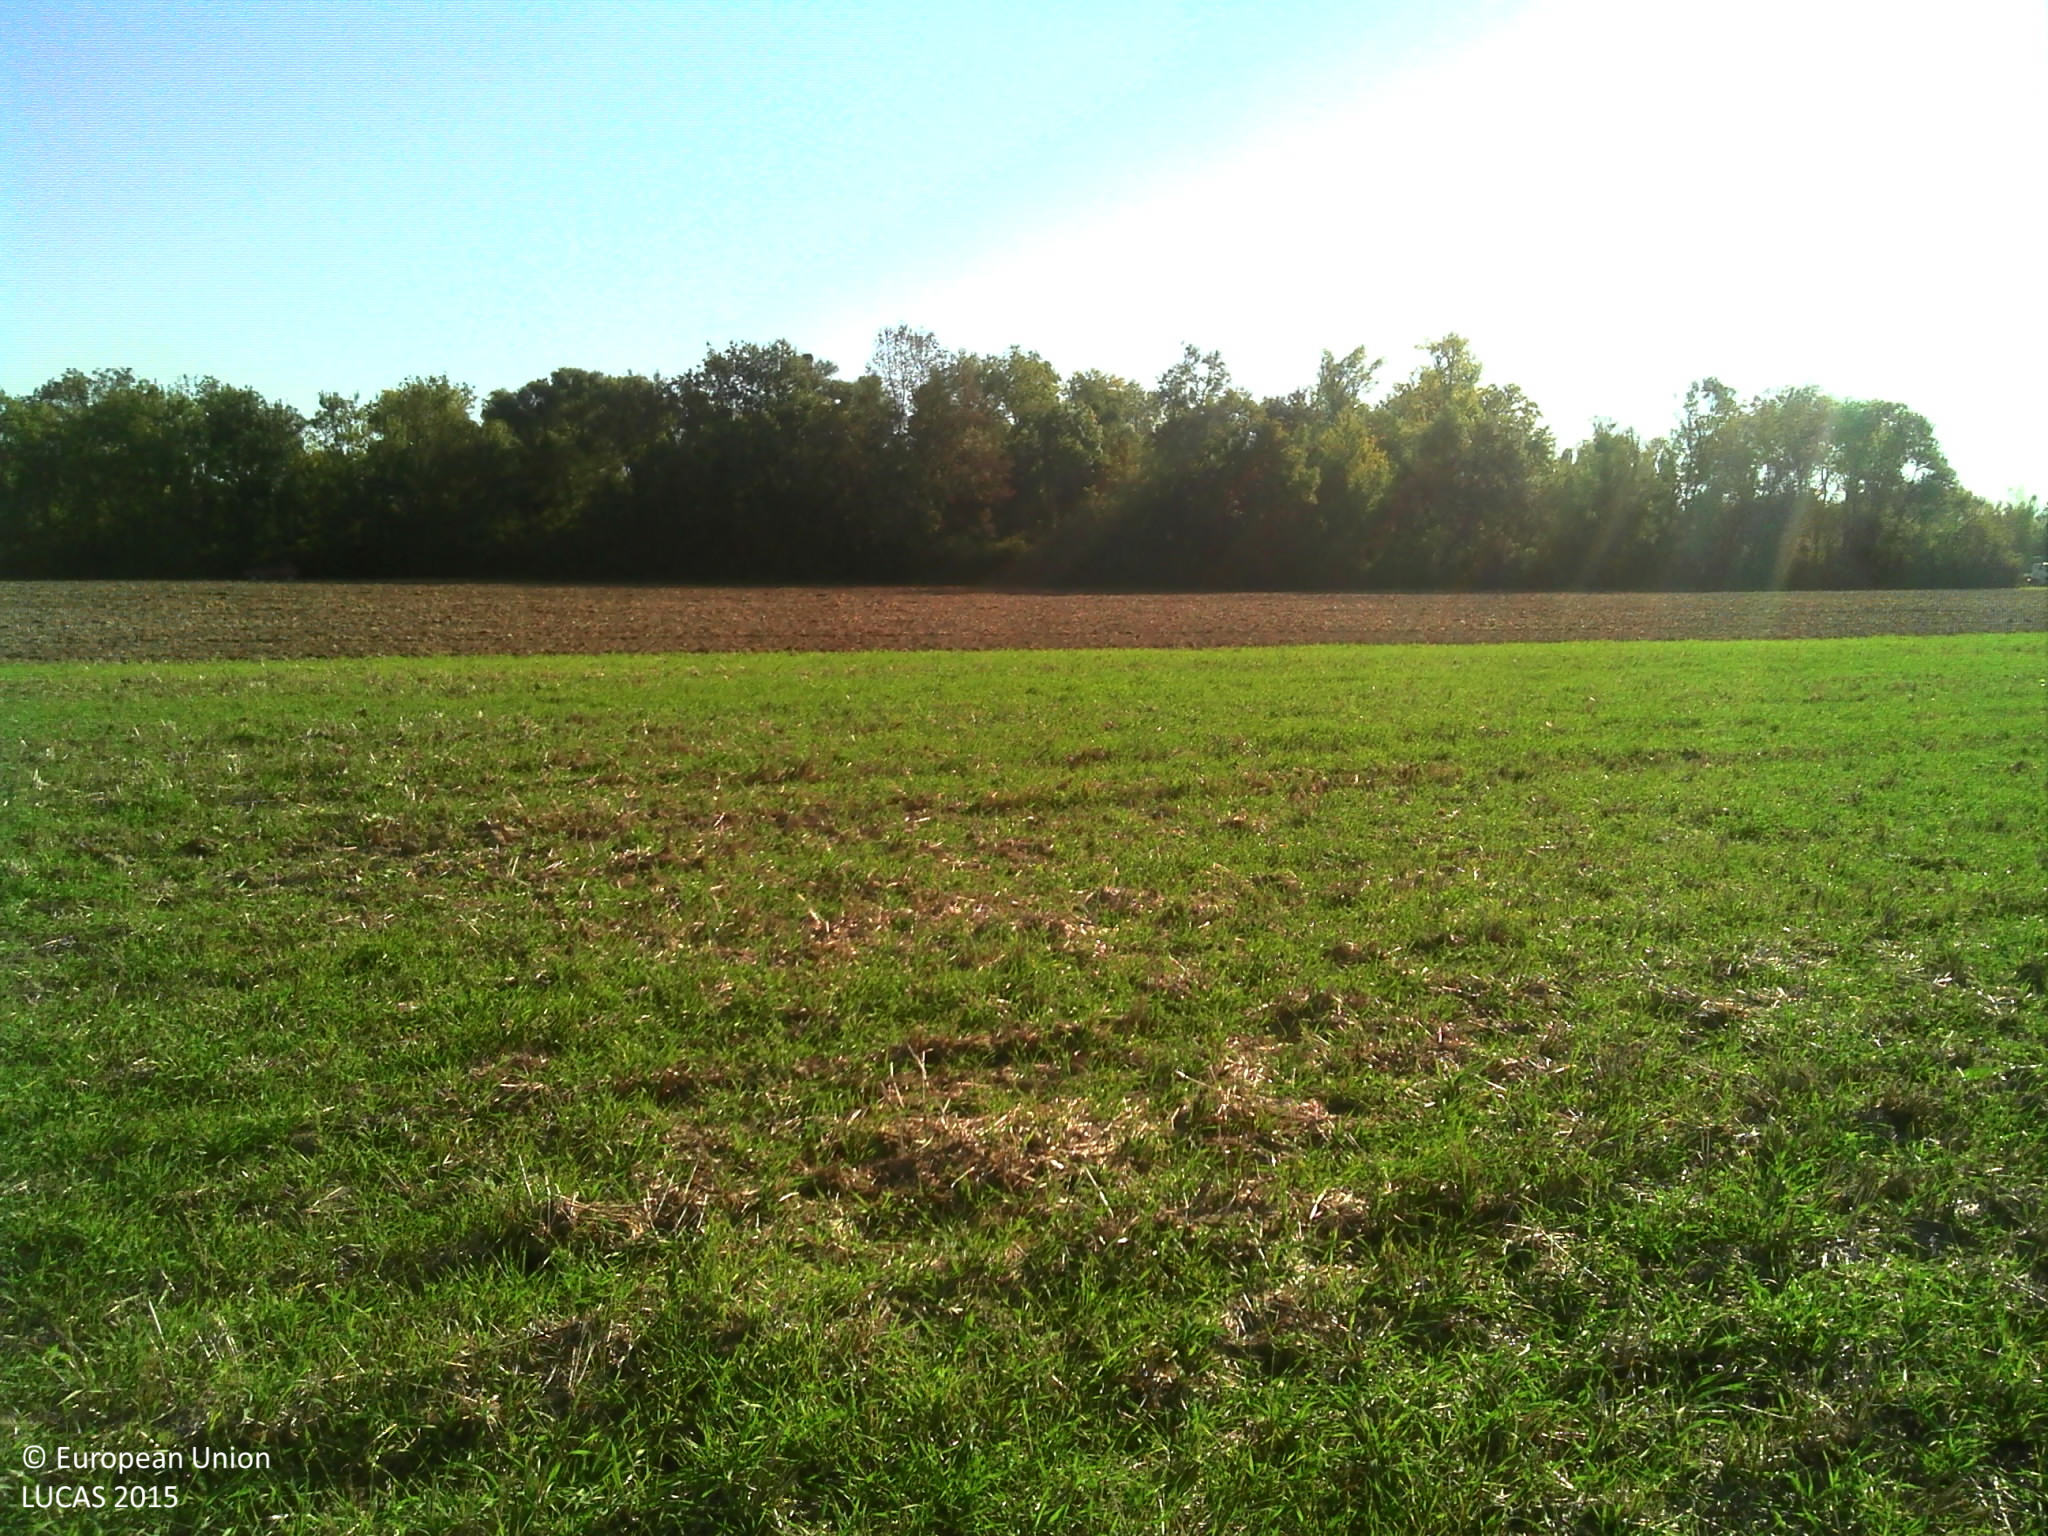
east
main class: Cropland
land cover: Common wheat
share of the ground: < 10 %
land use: Agriculture (excluding fallow land and kitchen gardens)
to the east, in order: Common wheat; Barley; Tracks; Broadleaved woodland; Inland fresh running water
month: September
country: FR
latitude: 48.4579
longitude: 3.3811
